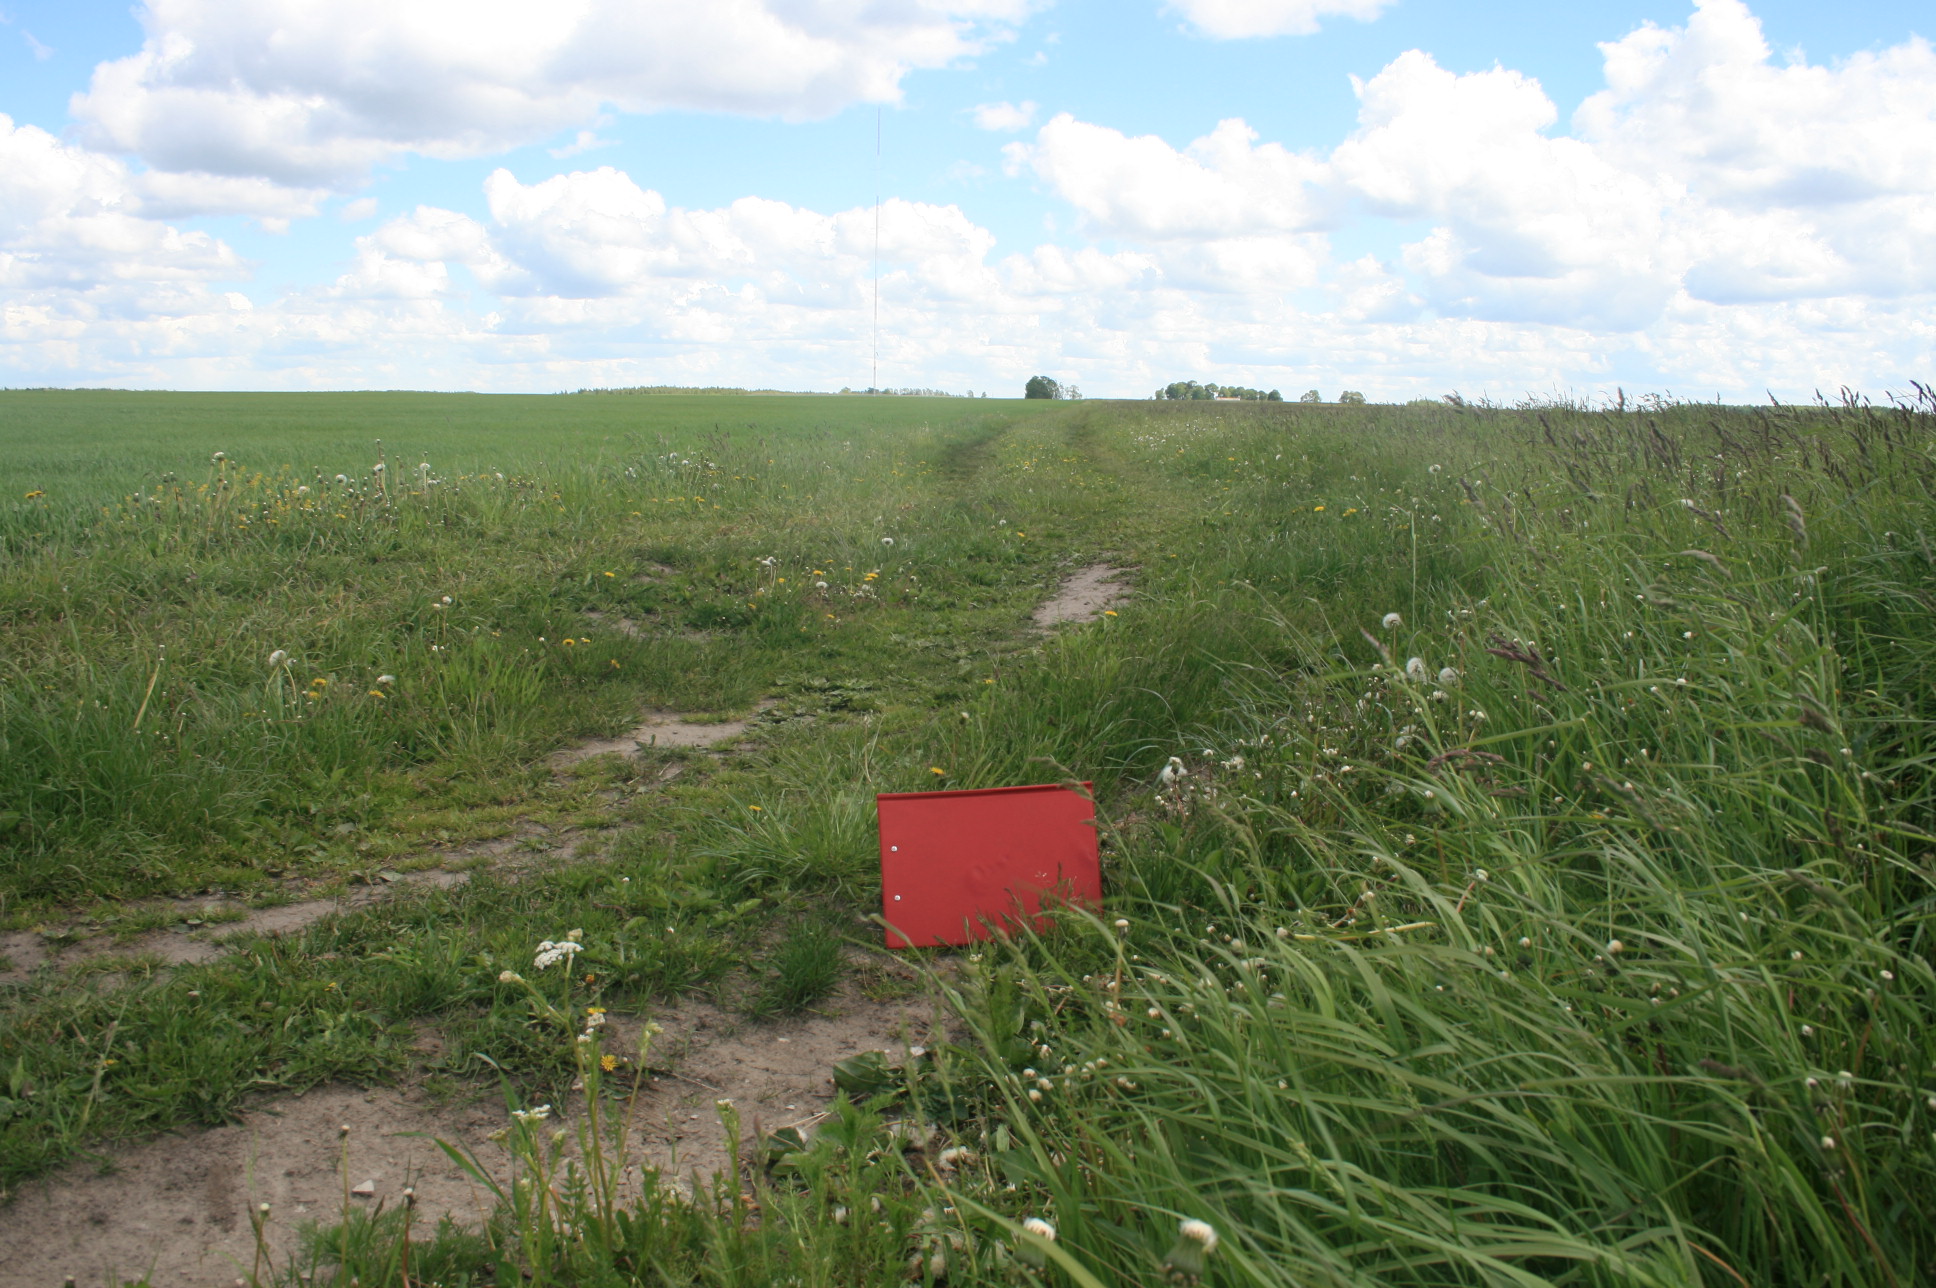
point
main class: Cropland
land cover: Oats
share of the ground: > 75 %
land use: Agriculture (excluding fallow land and kitchen gardens)
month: May
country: LT
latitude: 55.9888
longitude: 22.3520
